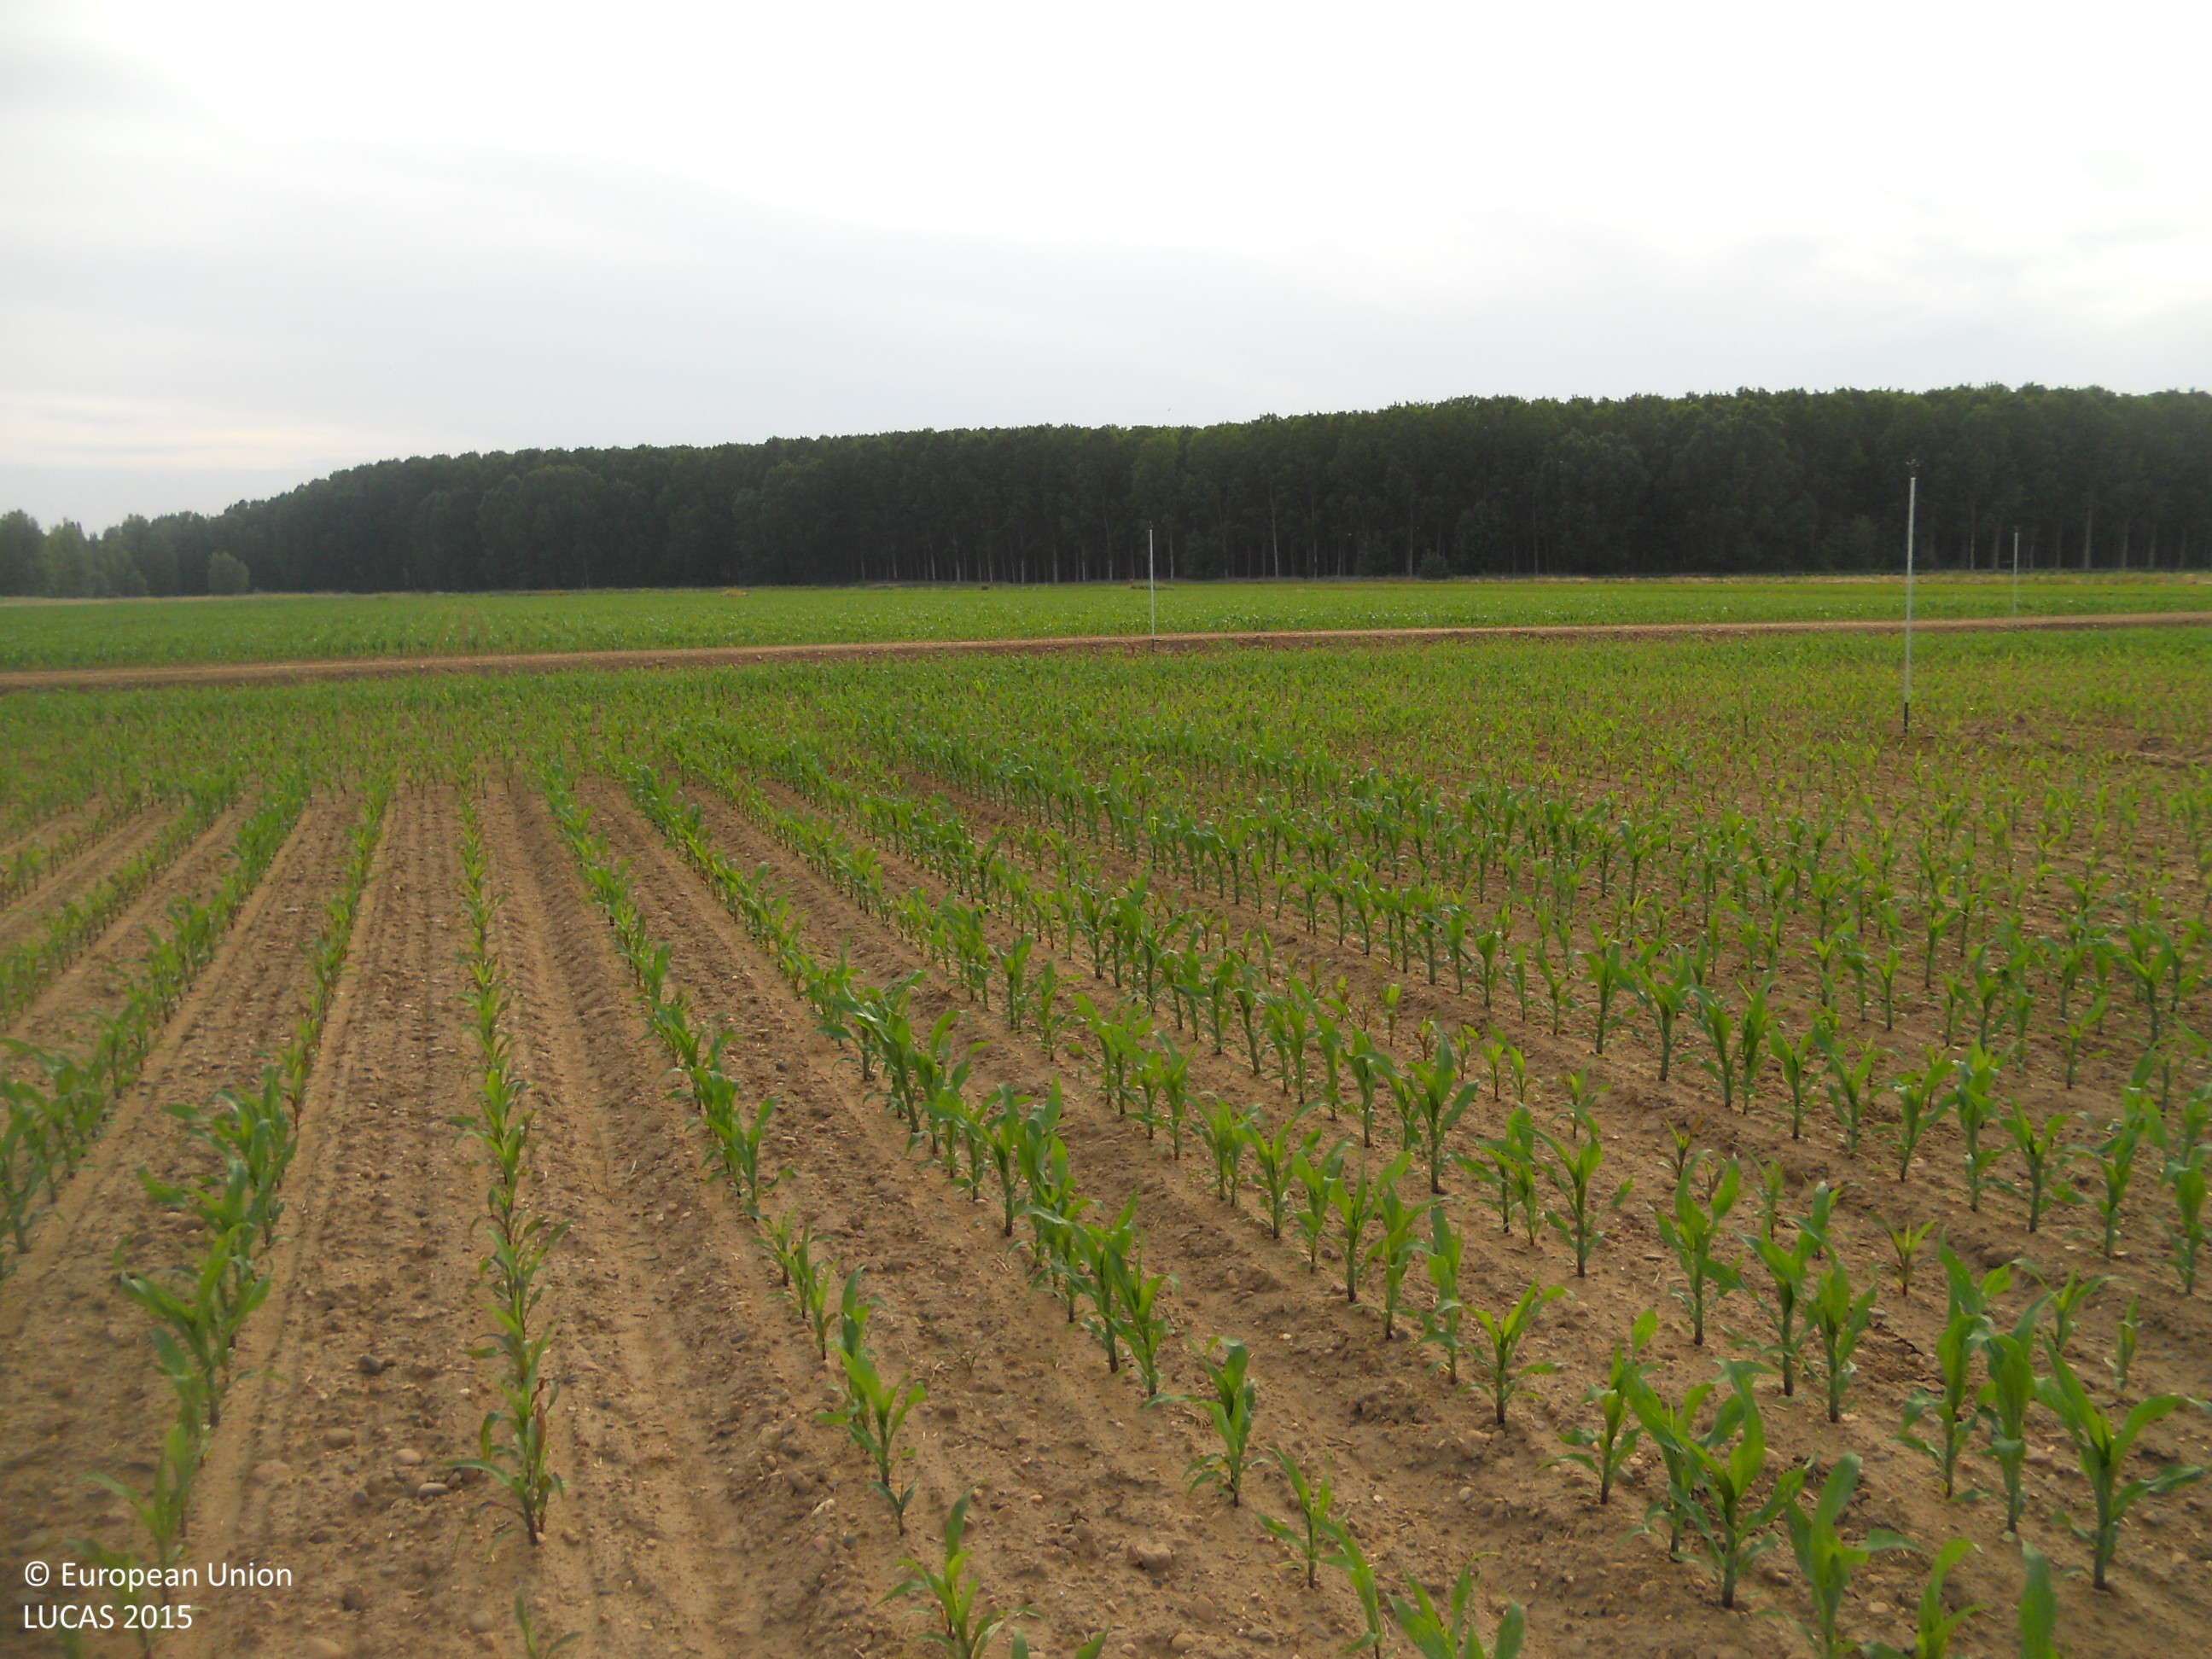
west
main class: Cropland
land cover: Maize
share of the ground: < 10 %
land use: Agriculture (excluding fallow land and kitchen gardens)
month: June
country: ES
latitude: 42.3623
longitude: -5.5504
